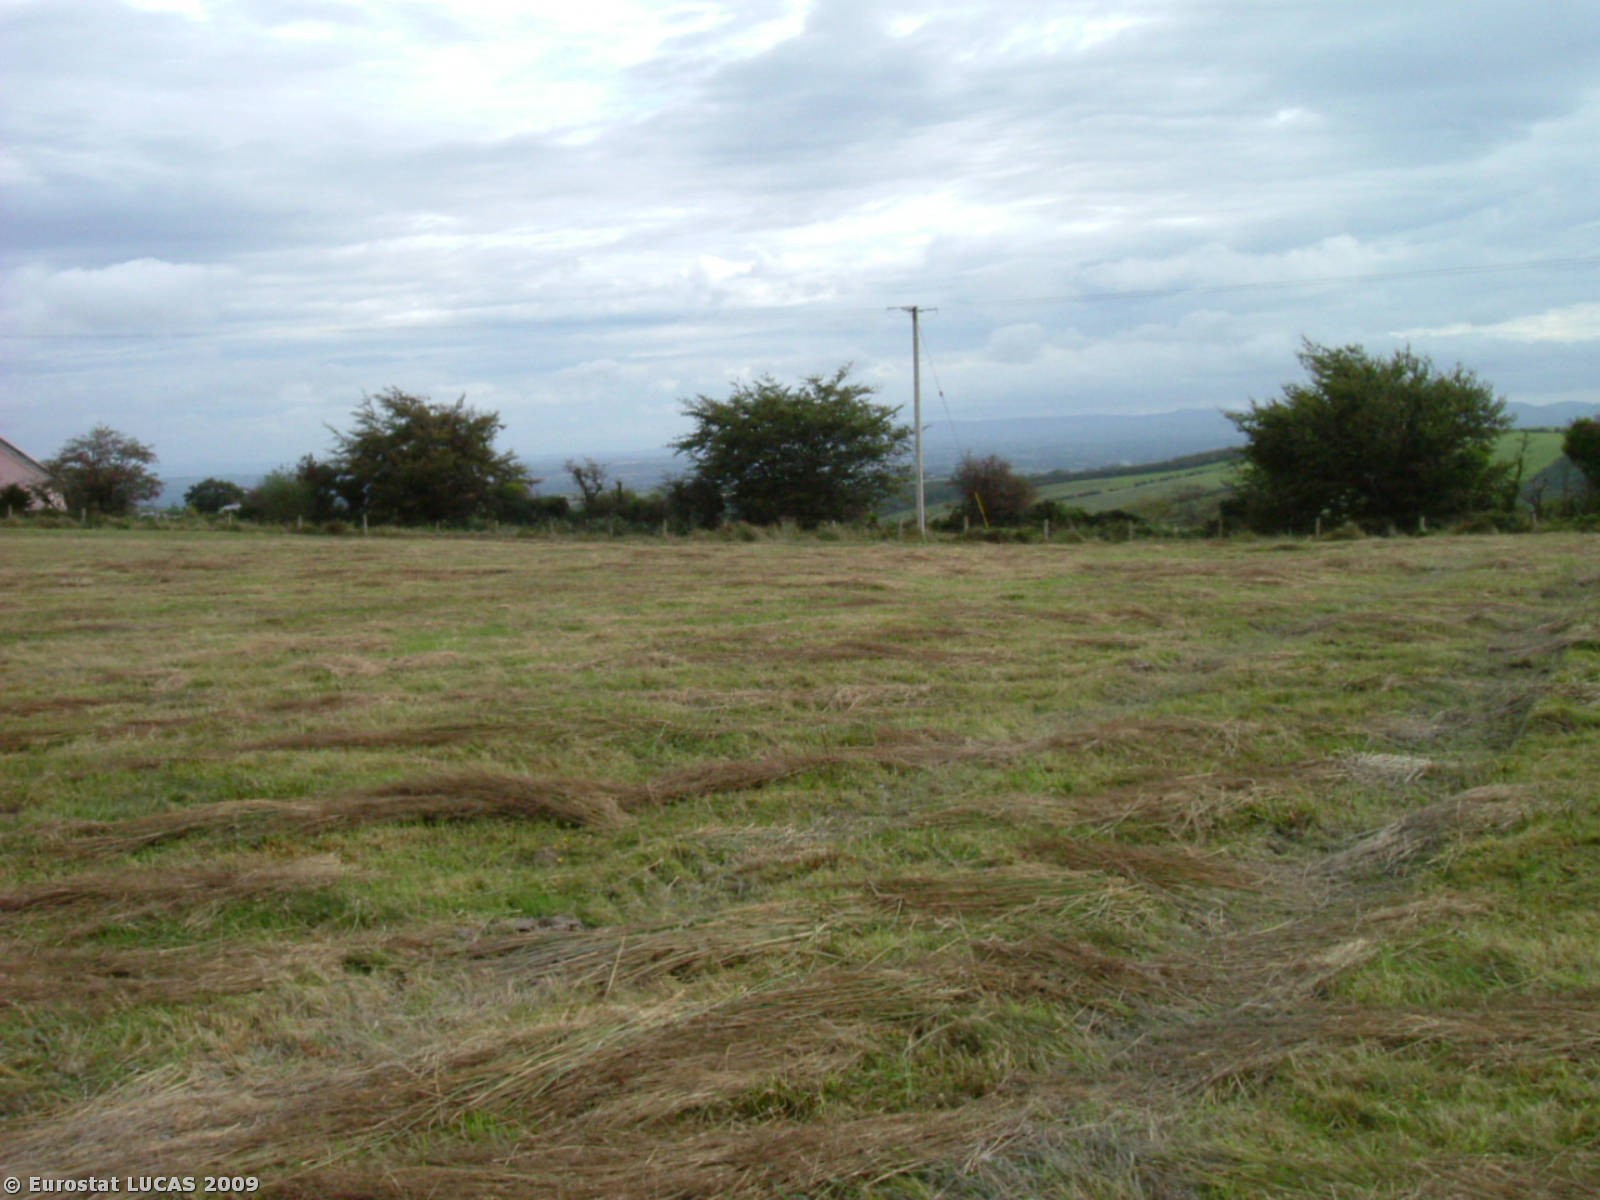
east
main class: Grassland
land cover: Grassland without tree/shrub cover
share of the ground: > 75 %
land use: Agriculture (excluding fallow land and kitchen gardens)
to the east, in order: Grassland without tree/shrub cover; Fences; Grass margins; Tracks; Grass margins; Managed hedges; Grassland without tree/shrub cover
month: September
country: IE
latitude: 52.8497
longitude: -8.3487
